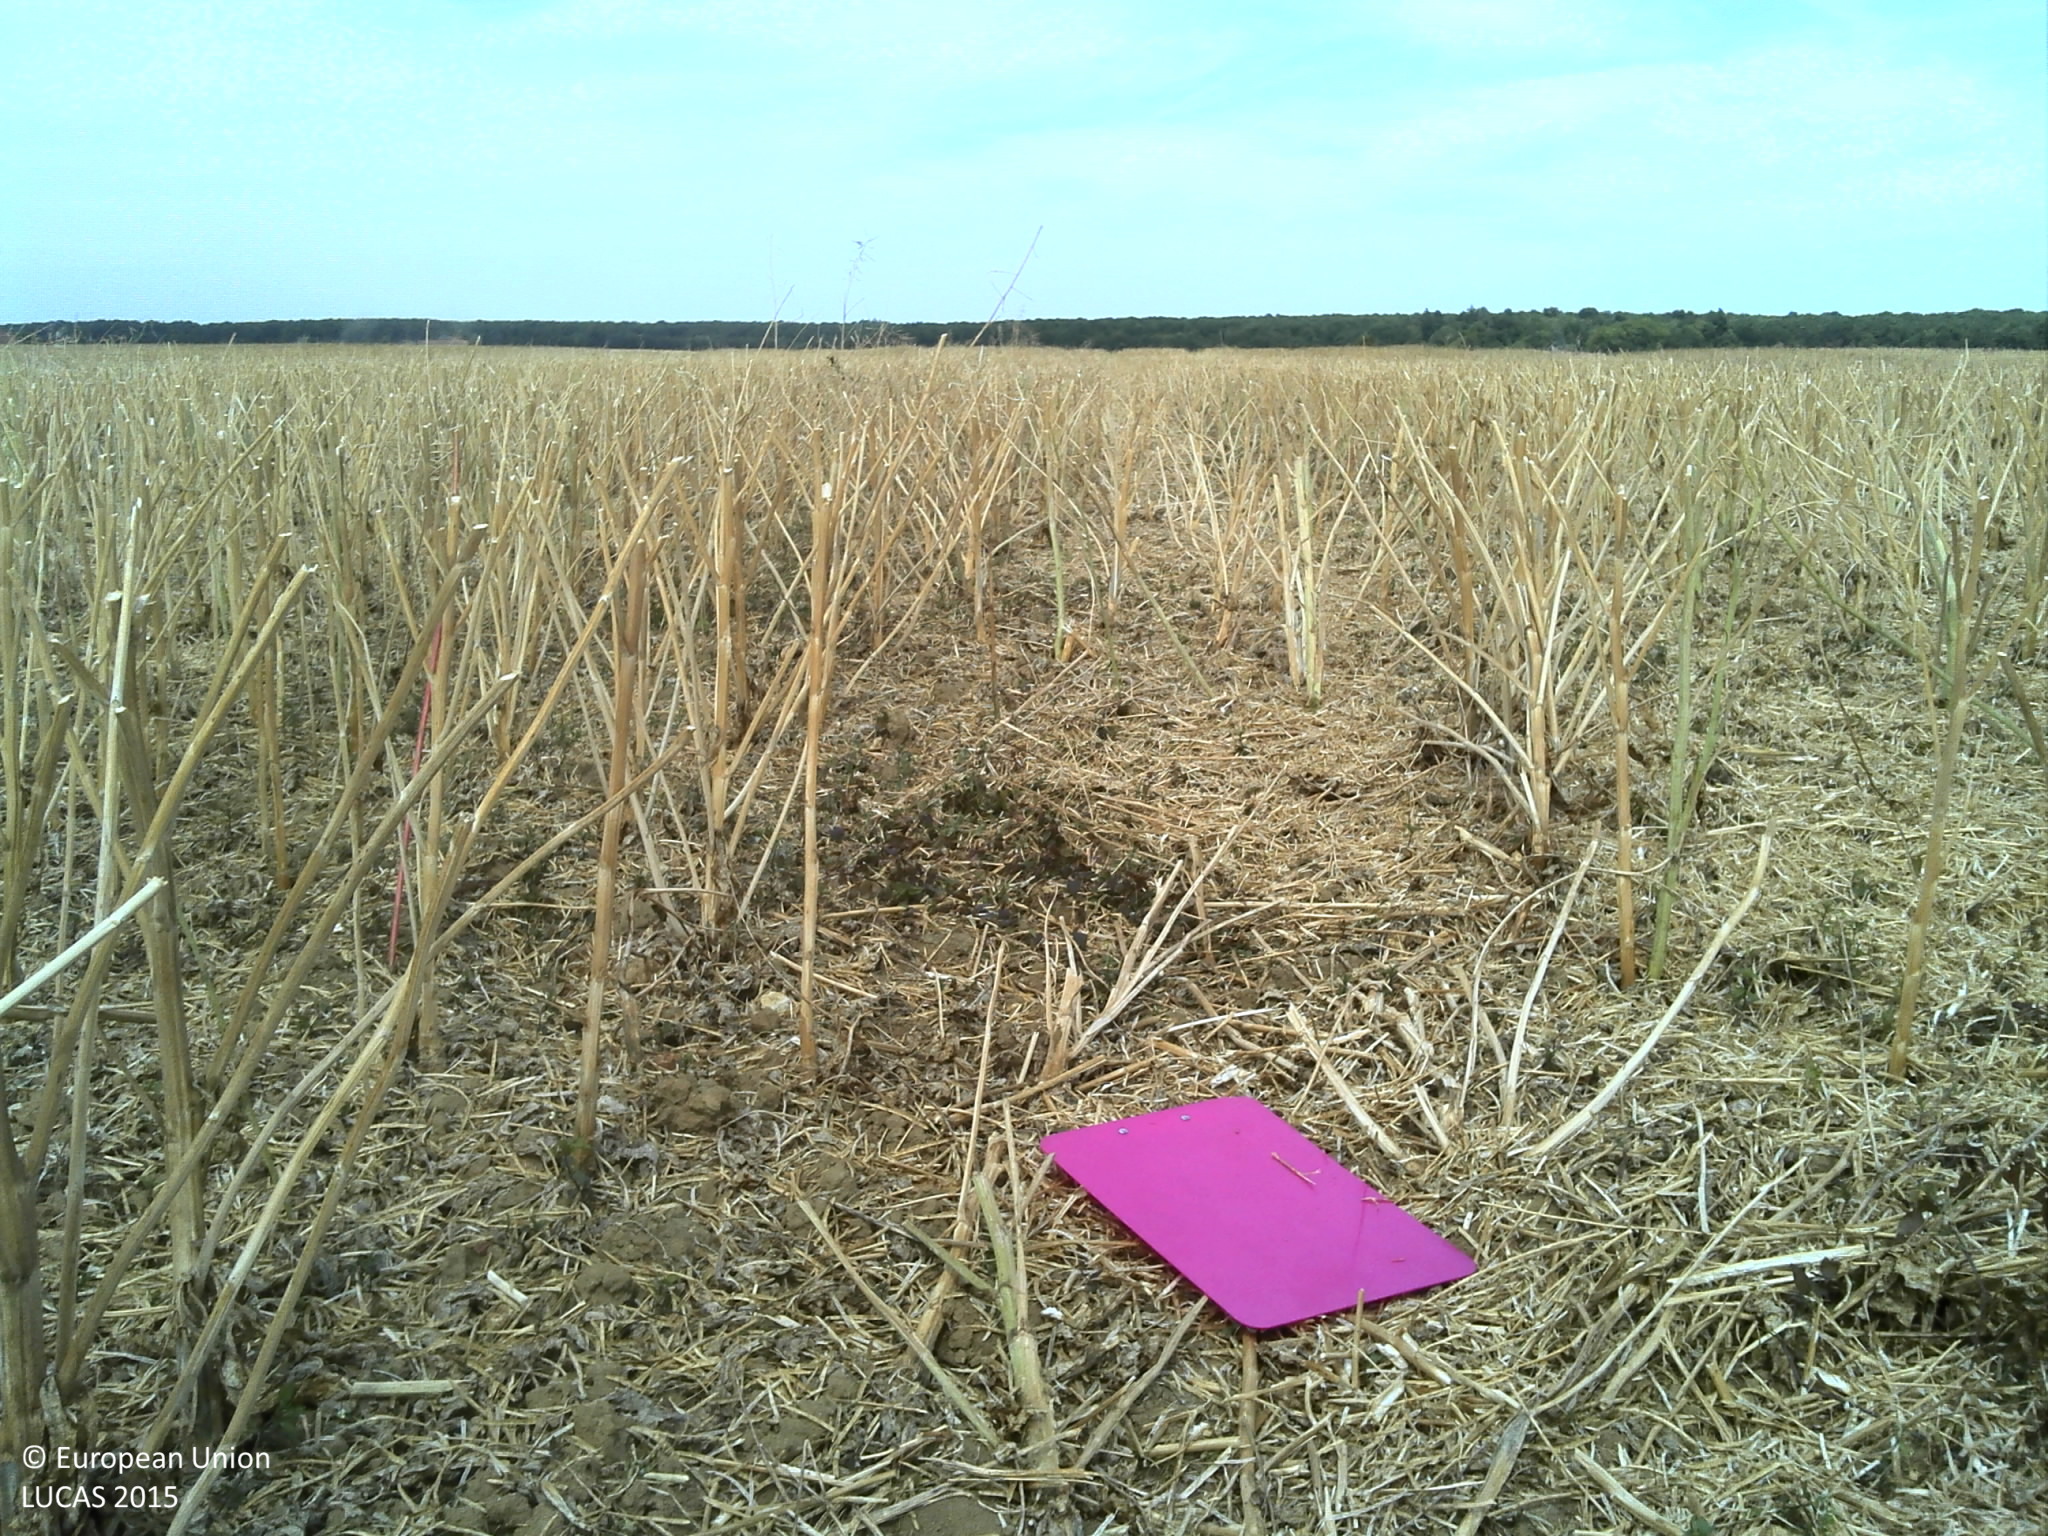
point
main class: Cropland
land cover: Rape and turnip rape
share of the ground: 25 - 50 %
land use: Agriculture (excluding fallow land and kitchen gardens)
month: August
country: FR
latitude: 48.5916
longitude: 1.8641
